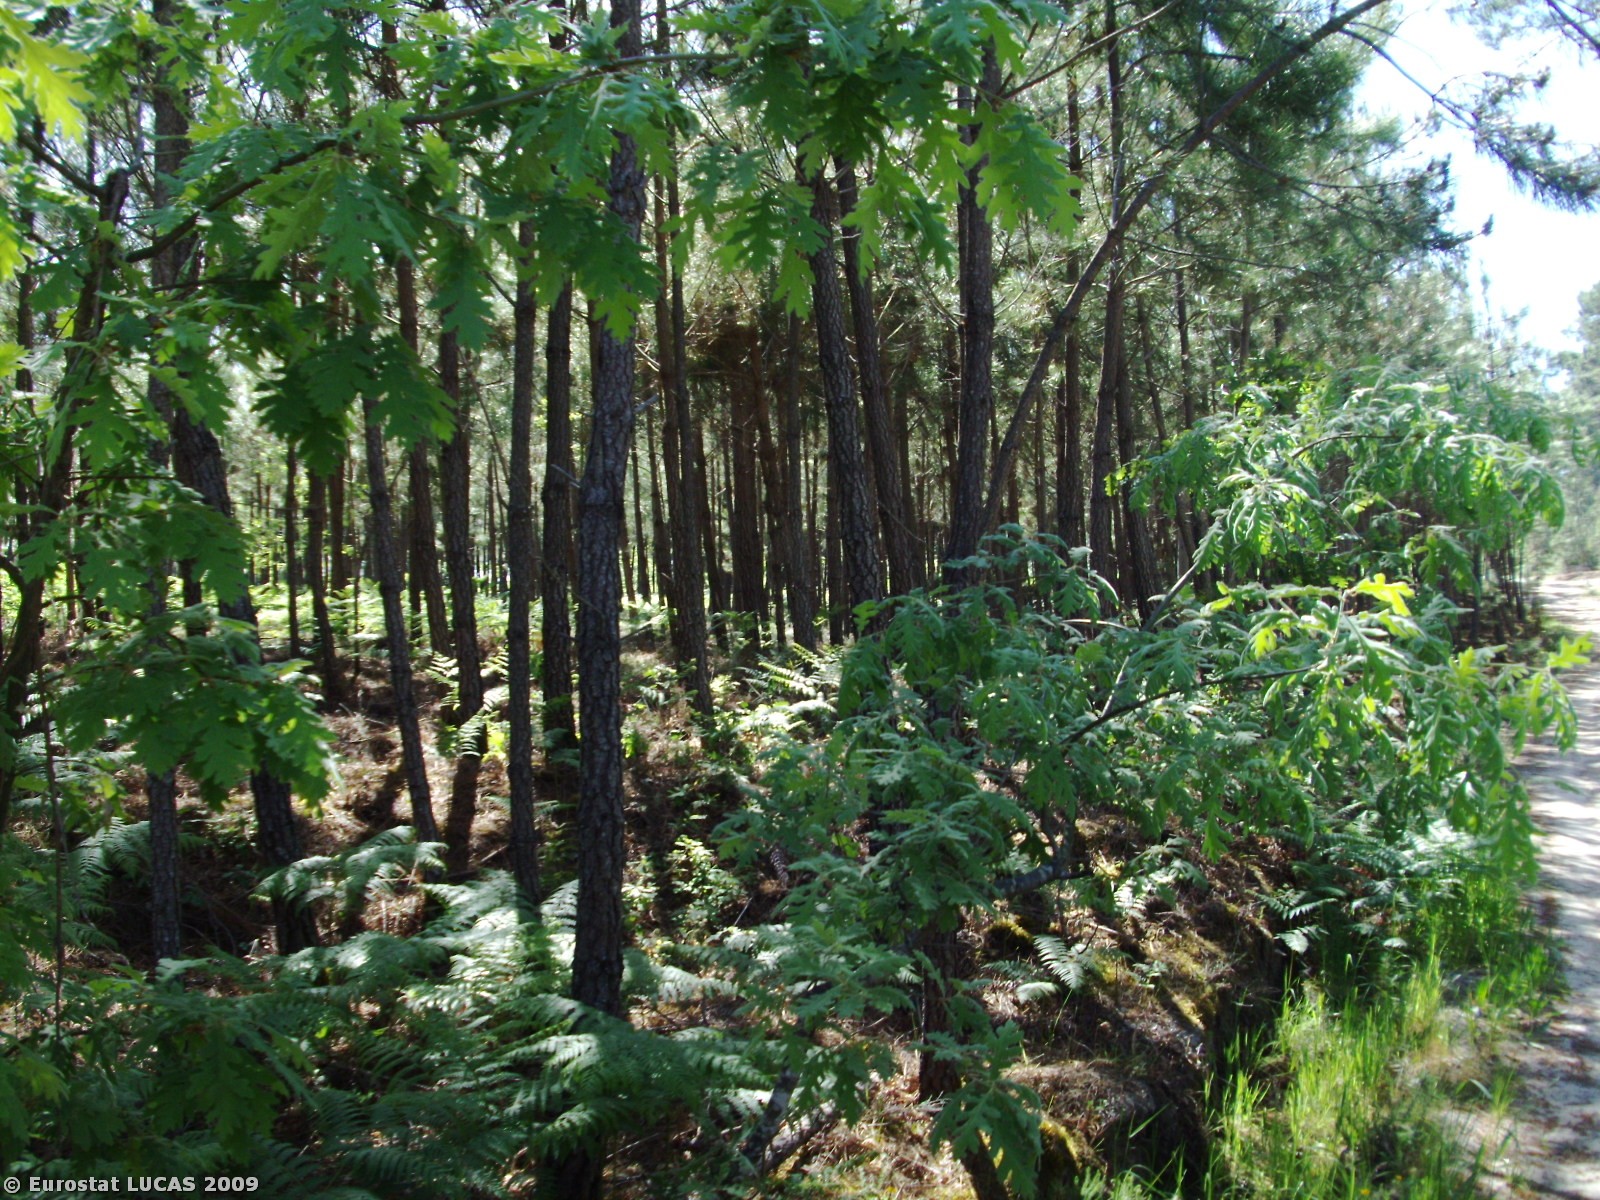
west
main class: Woodland
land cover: Coniferous woodland
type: coniferous forest of the mediterranean region
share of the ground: > 75 %
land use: Forestry
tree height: > 5 m
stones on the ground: 25 - 50 %
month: May
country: PT
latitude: 40.8154
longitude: -7.5328
